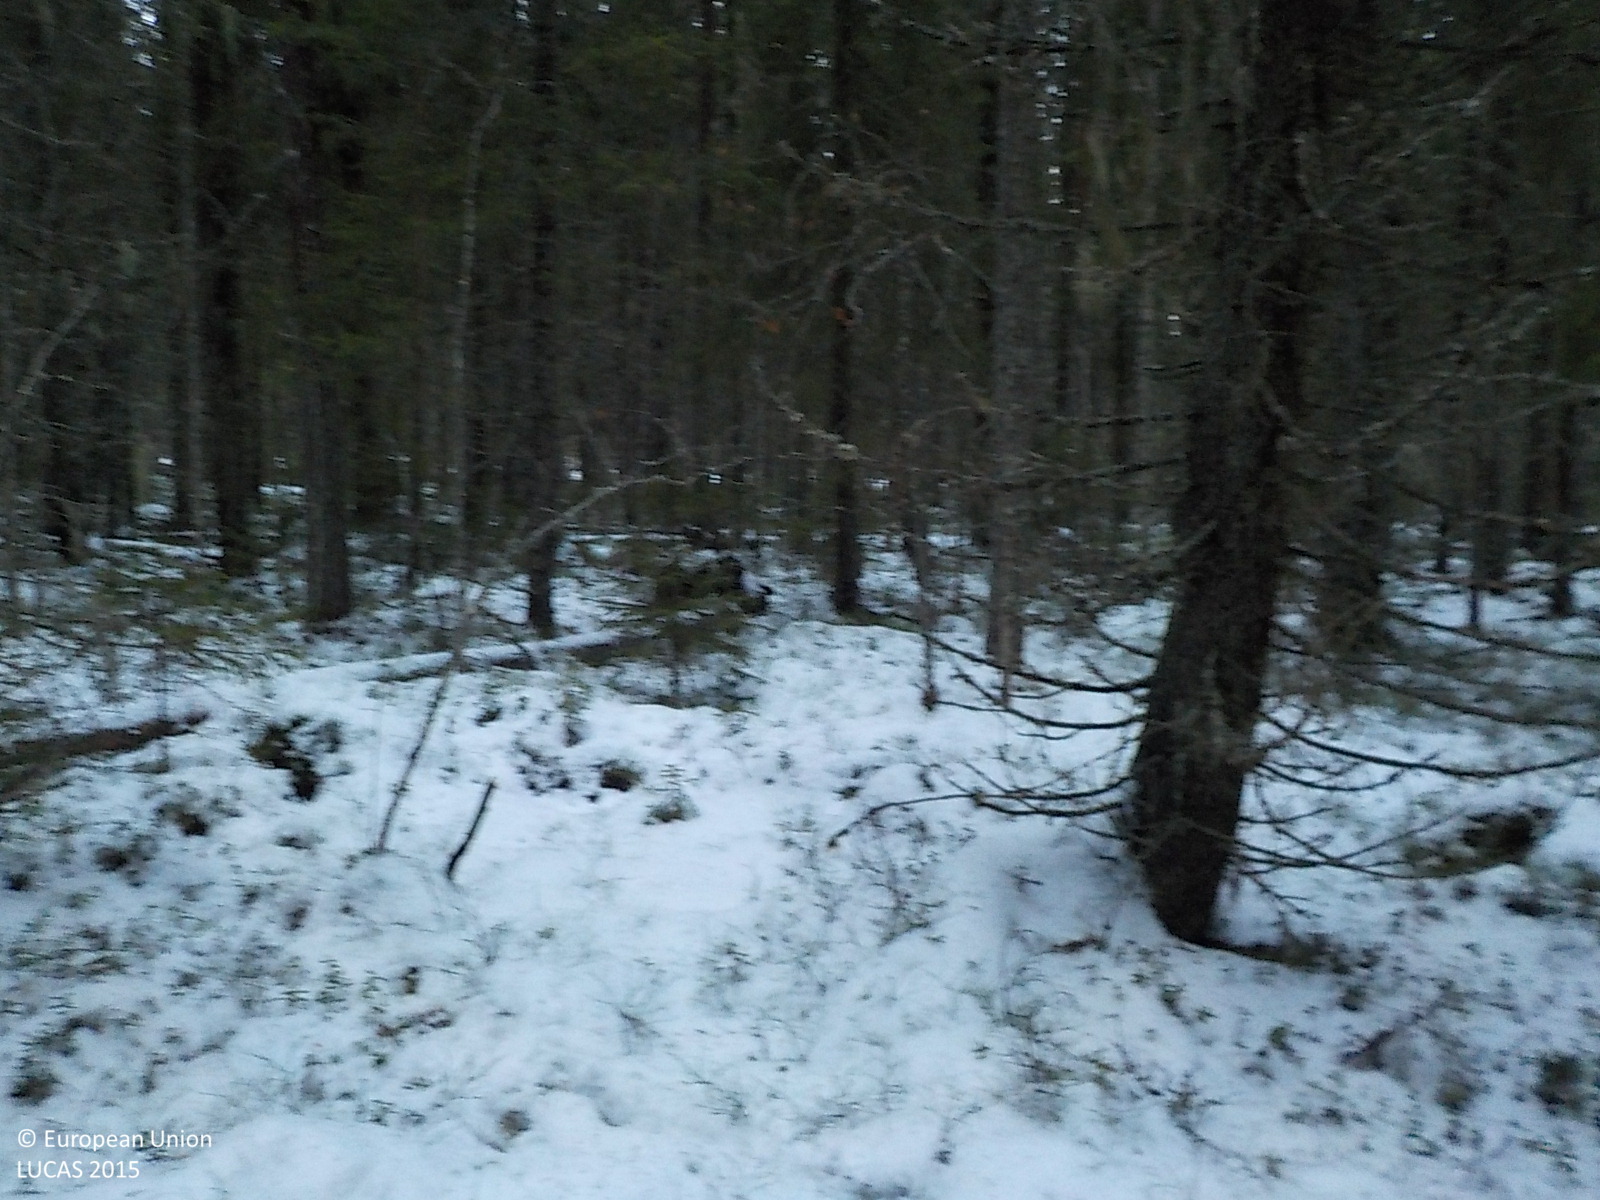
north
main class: Woodland
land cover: Spruce dominated coniferous woodland
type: boreal forest
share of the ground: > 75 %
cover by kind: coniferous forest trees 75 %, shrubs 10 %, broadleaved forest trees 5 %, herbaceous plants 5 %, lichens and mosses 5 %
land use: Forestry
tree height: > 5 m
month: December
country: SE
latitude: 63.5150
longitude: 16.6664
